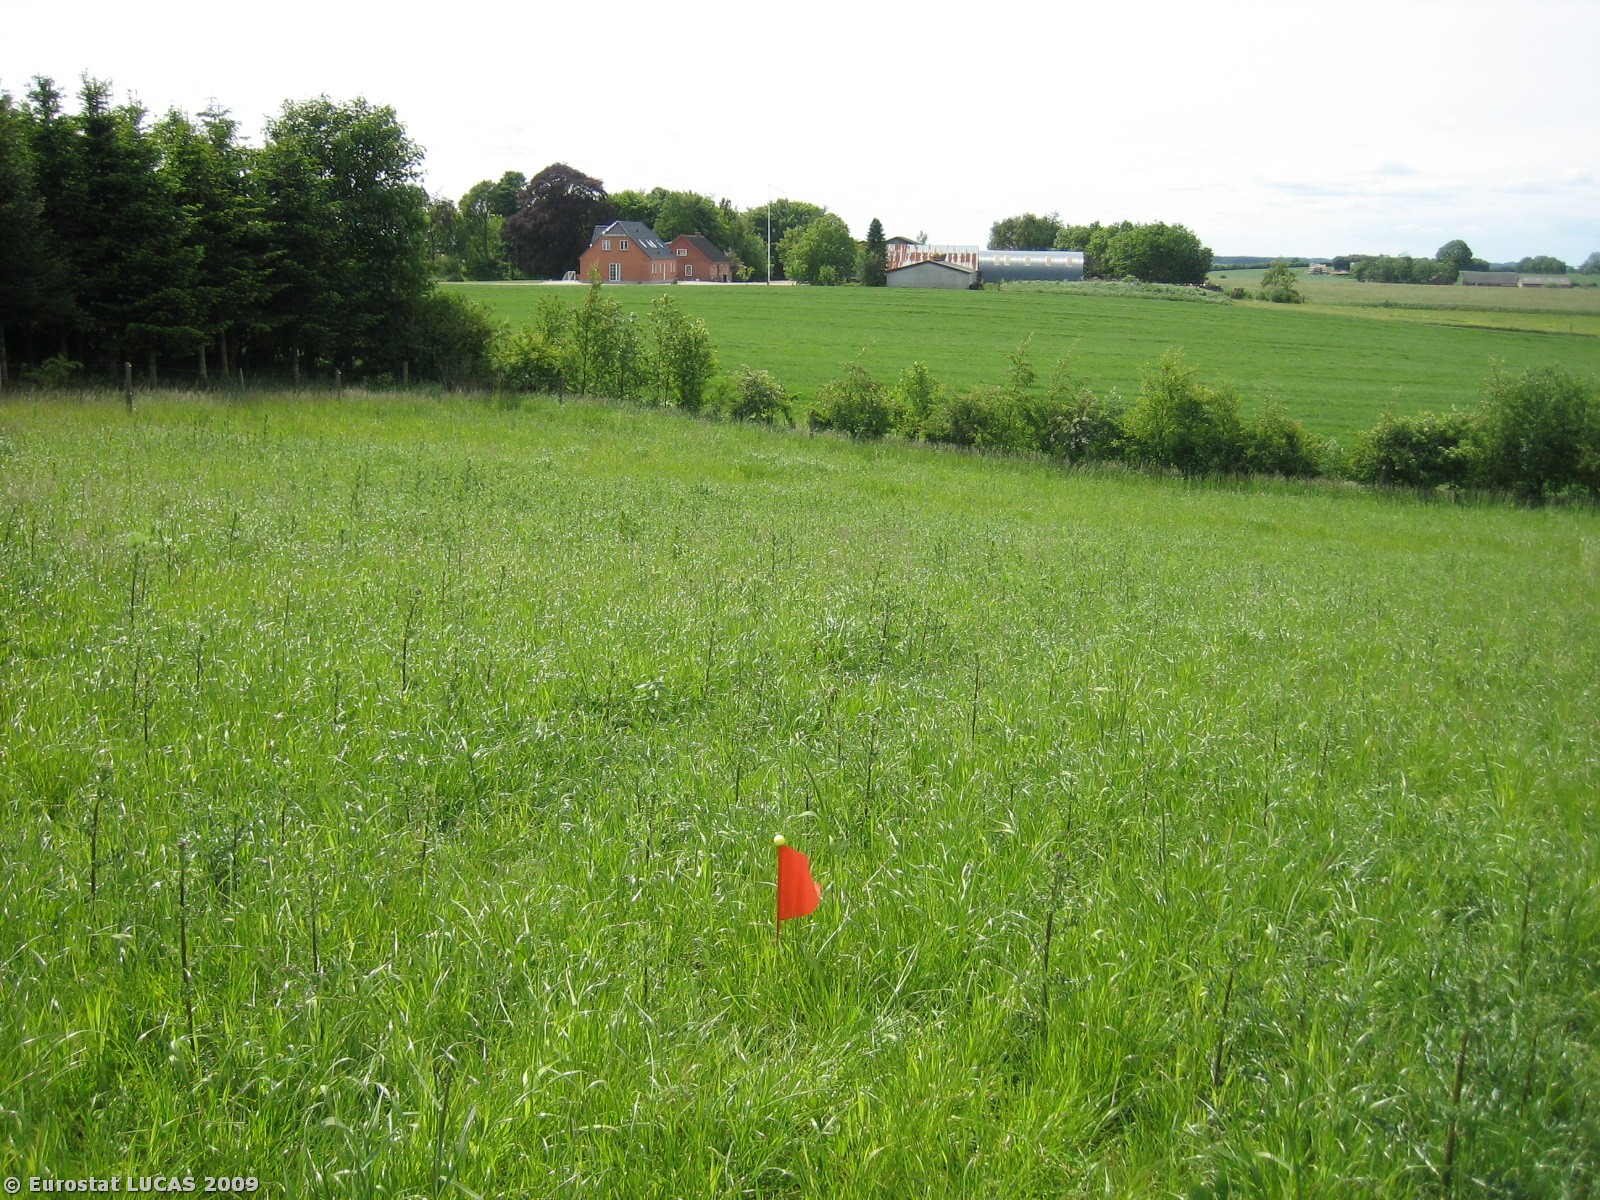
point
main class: Grassland
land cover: Grassland without tree/shrub cover
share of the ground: > 75 %
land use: Agriculture (excluding fallow land and kitchen gardens)
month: June
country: DK
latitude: 56.1875
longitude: 9.7586
